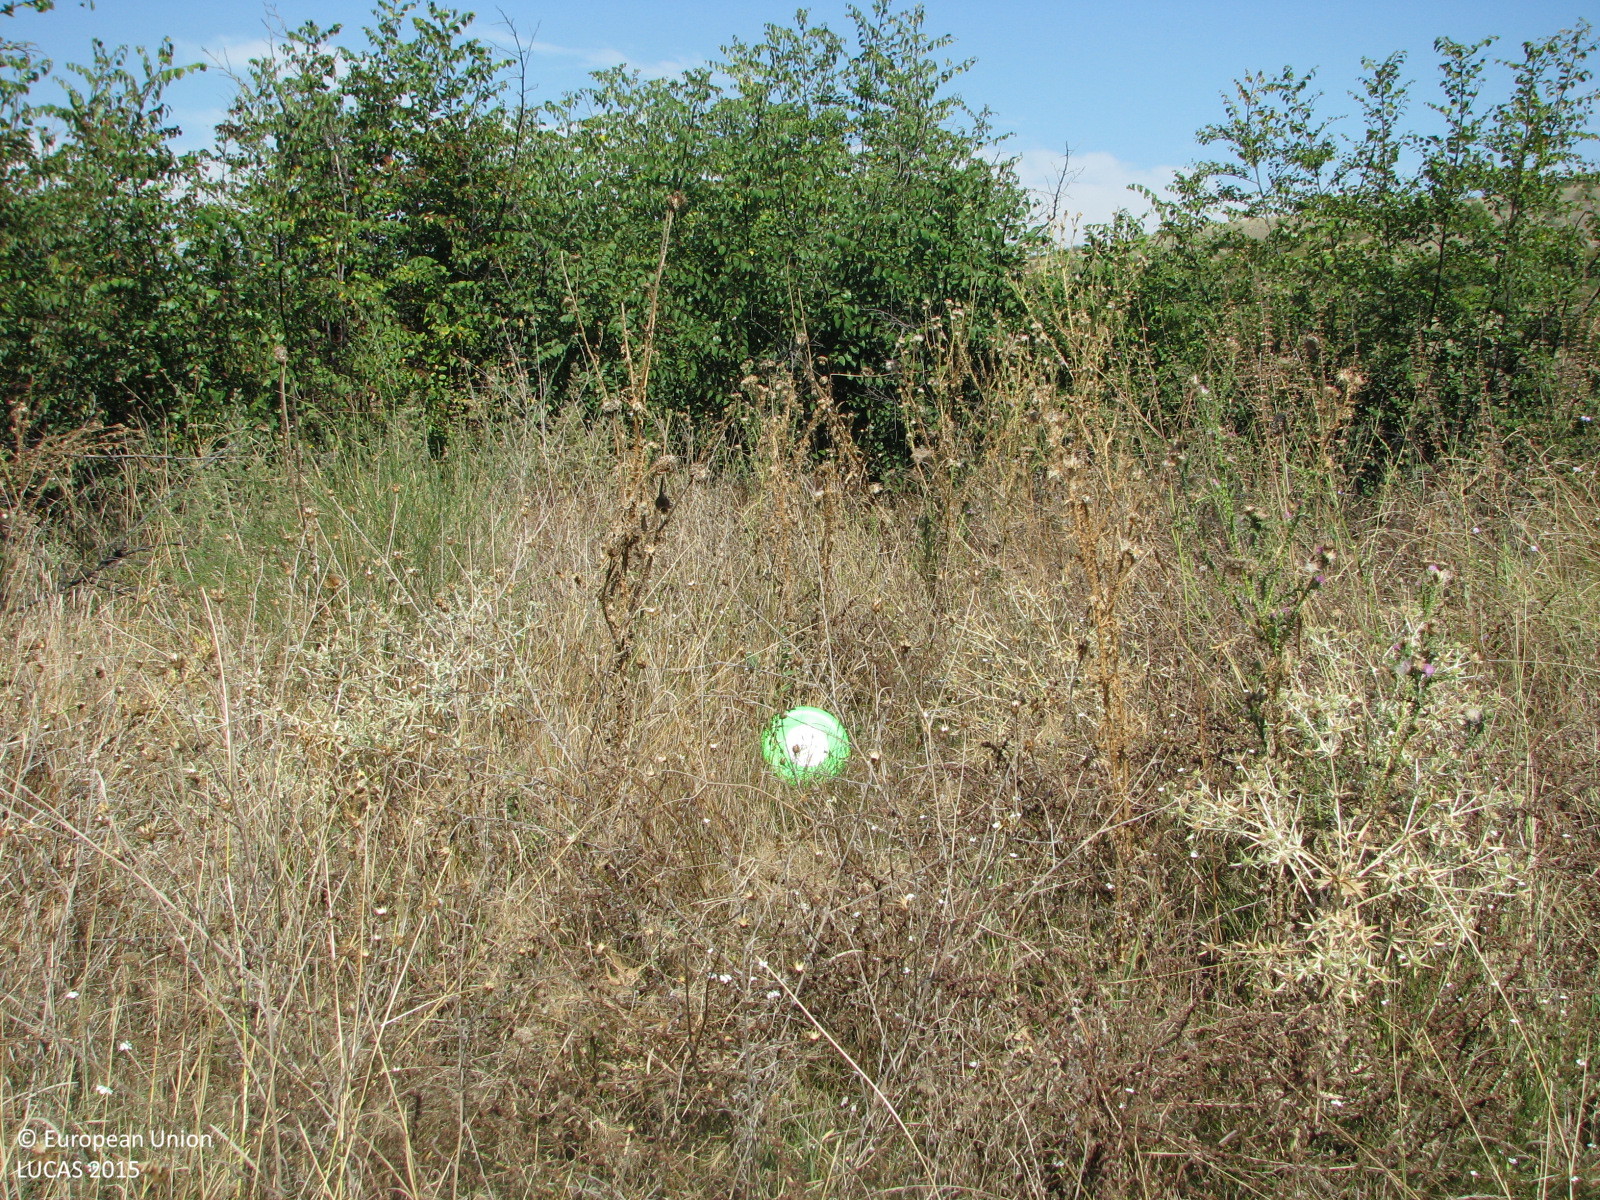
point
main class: Shrubland
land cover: Shrubland without tree cover
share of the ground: 50 - 75 %
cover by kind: shrubs 60 %, herbaceous plants 40 %
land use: Agriculture (excluding fallow land and kitchen gardens)
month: September
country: BG
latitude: 42.5493
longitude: 26.2224
